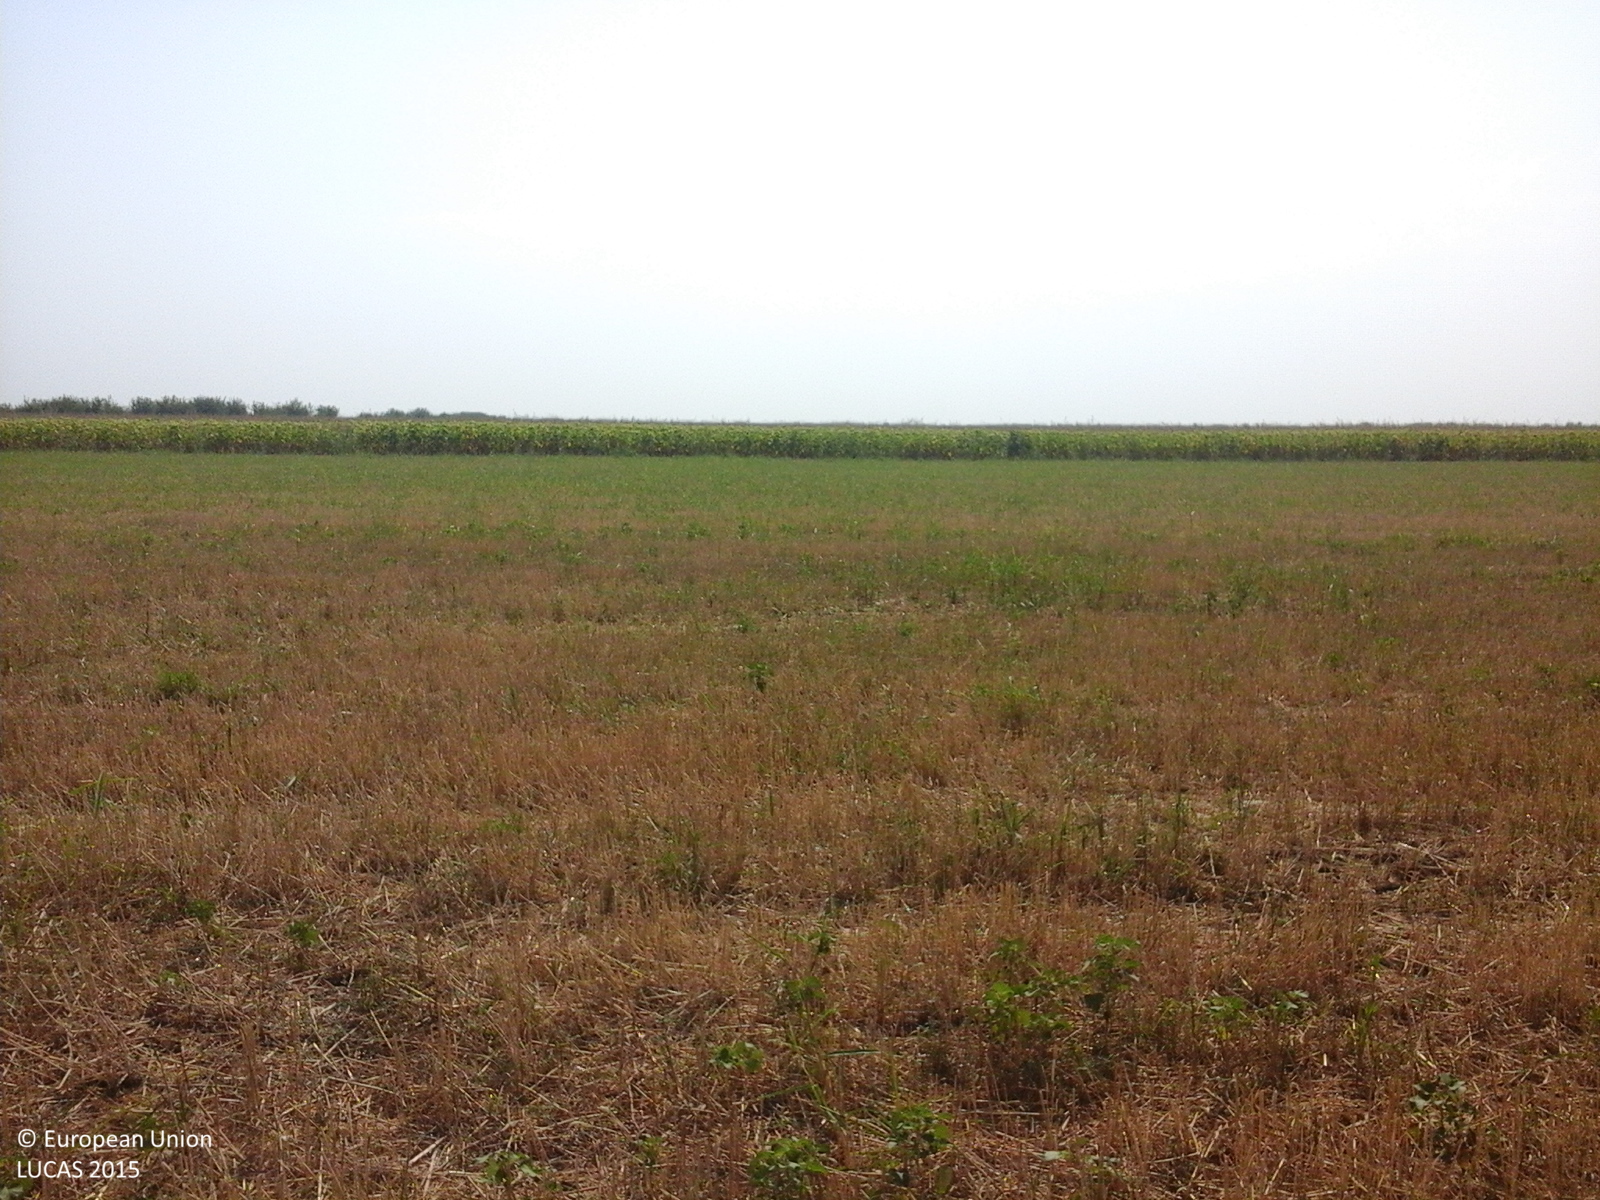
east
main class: Cropland
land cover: Common wheat
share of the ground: > 75 %
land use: Agriculture (excluding fallow land and kitchen gardens)
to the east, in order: Common wheat; Sunflower; Maize; Common wheat
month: August
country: RO
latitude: 43.9574
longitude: 23.2166
